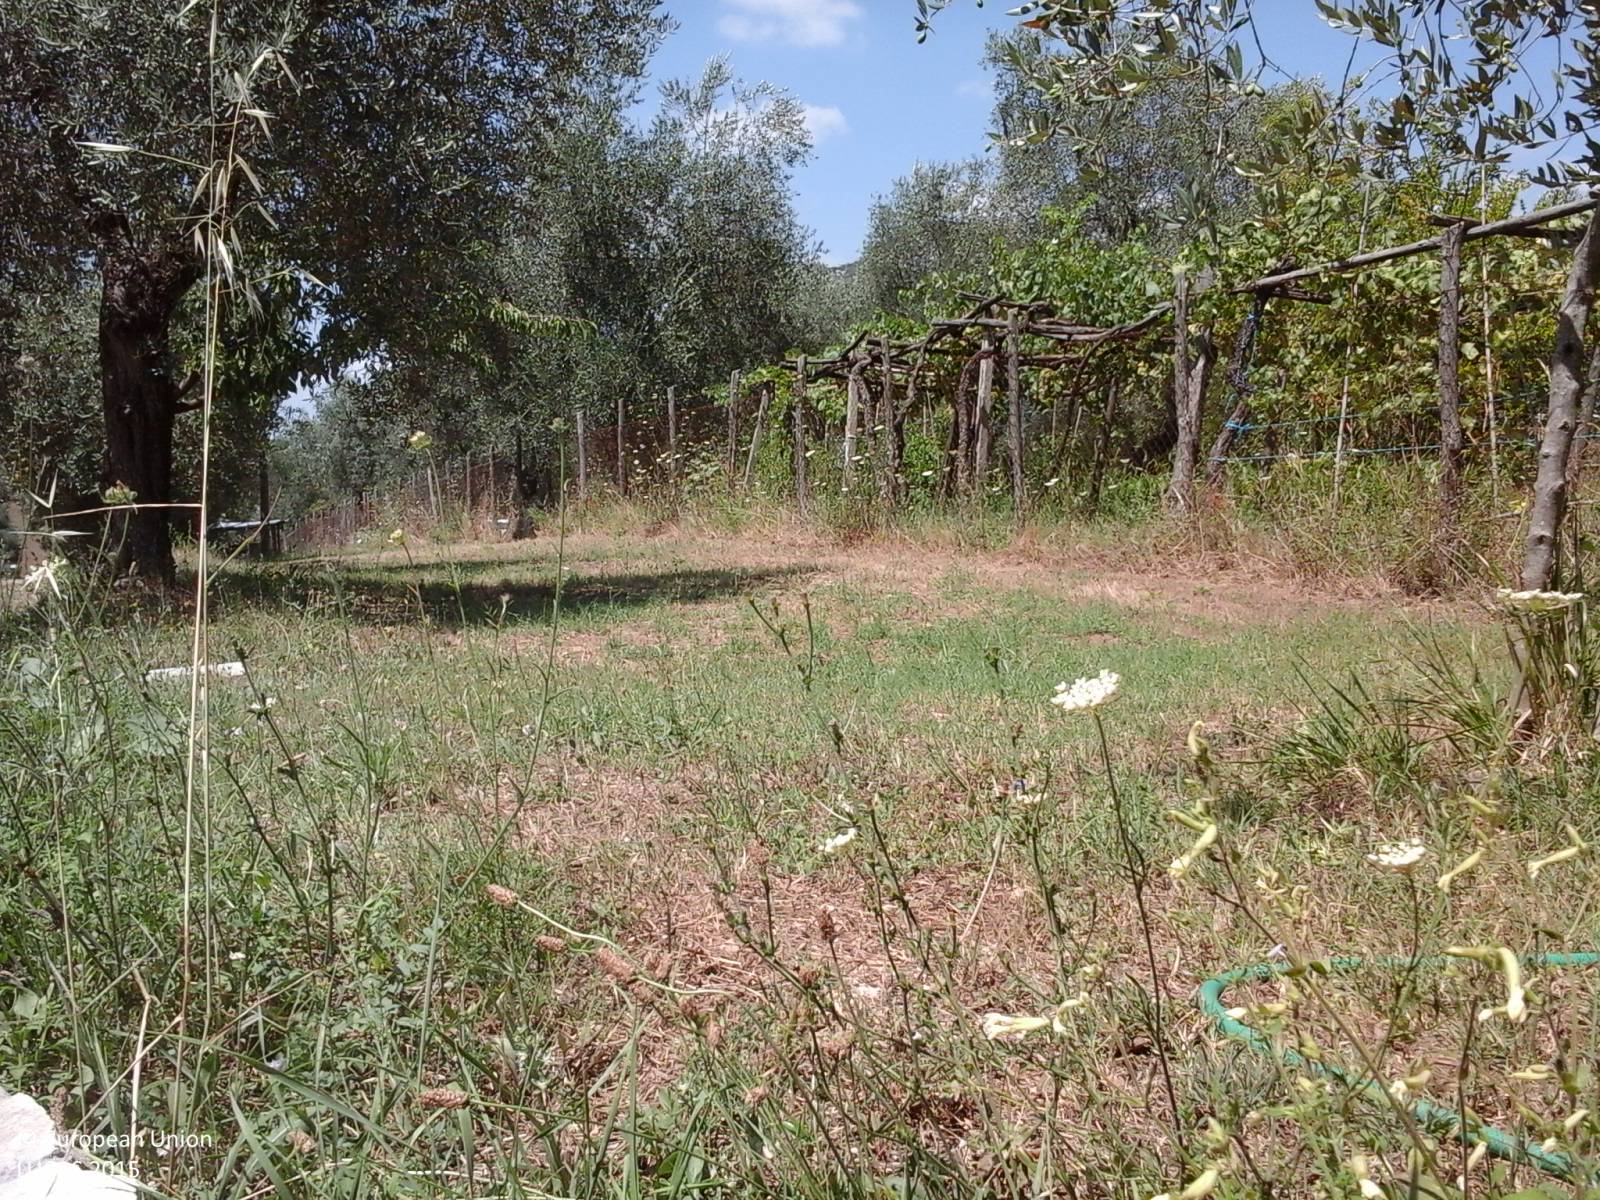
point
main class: Cropland
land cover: Olive groves
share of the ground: > 75 %
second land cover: Spontaneously vegetated surfaces
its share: > 75 %
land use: Kitchen garden
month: July
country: IT
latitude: 42.2250
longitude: 12.5234
